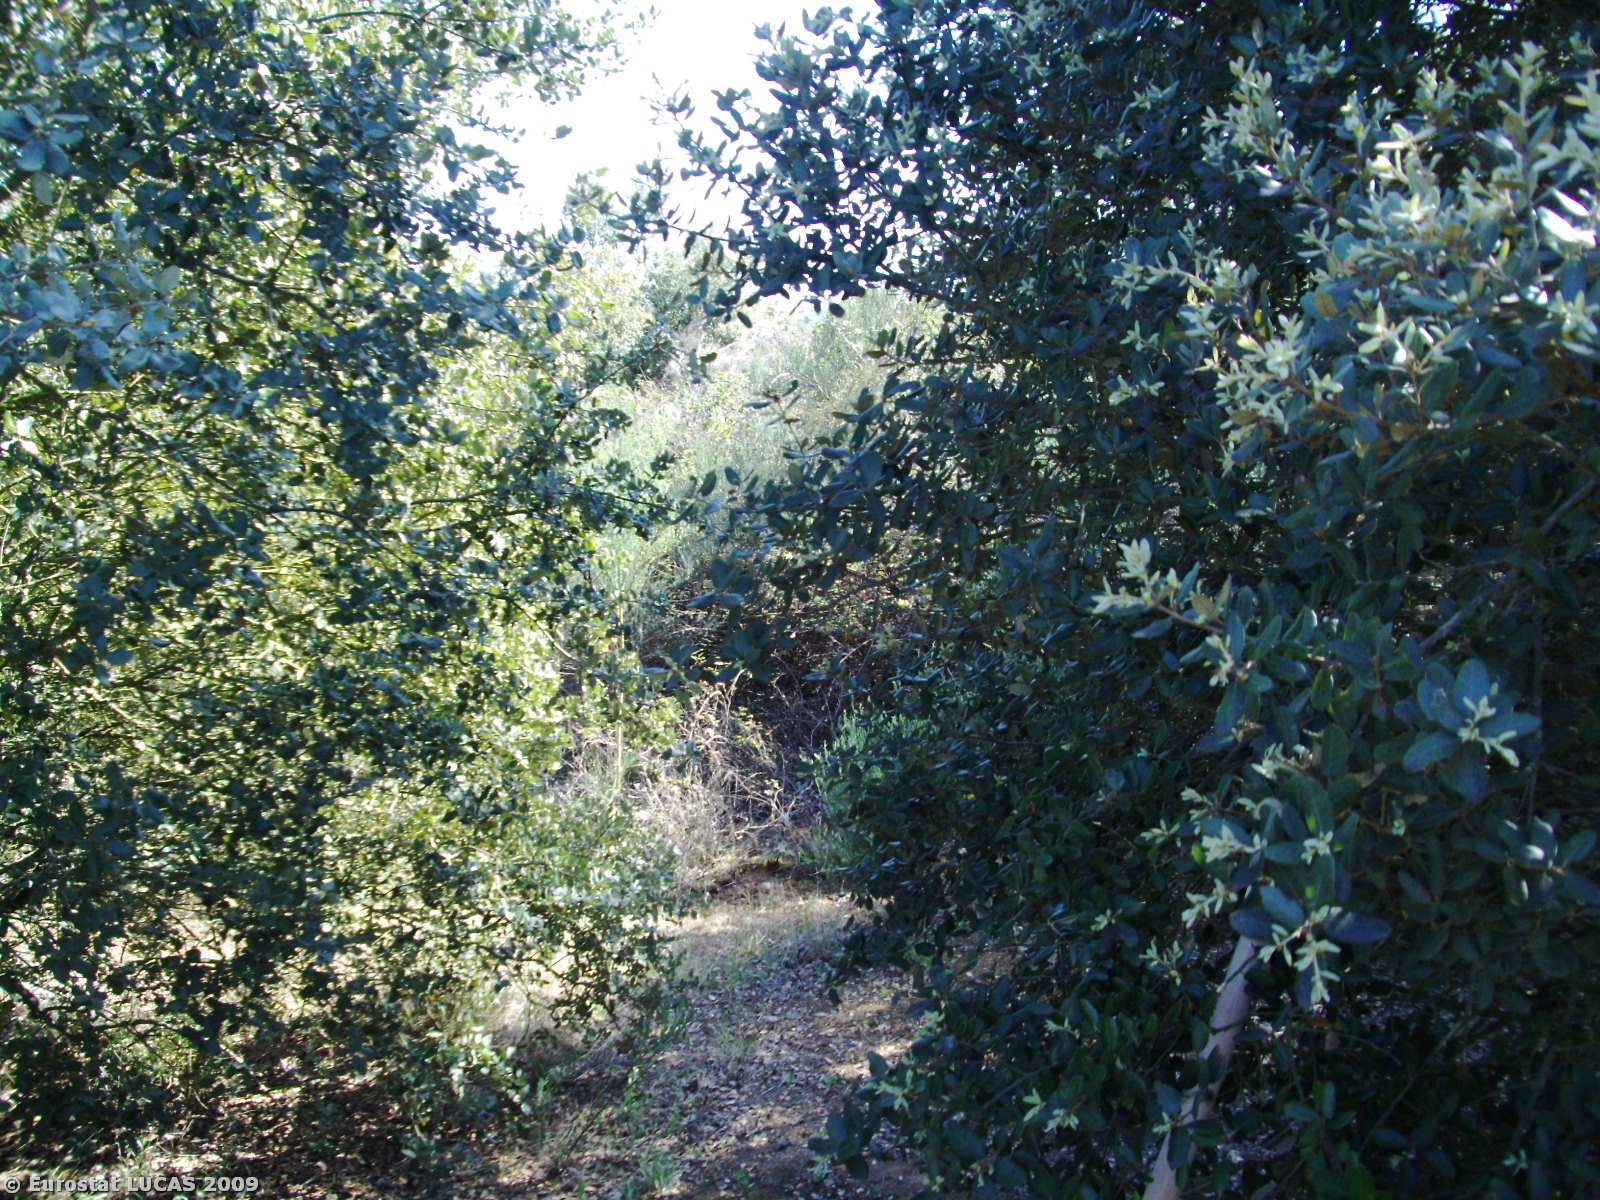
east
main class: Woodland
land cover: Broadleaved woodland
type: broadleaved evergreen forest
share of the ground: > 75 %
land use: Forestry
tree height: > 5 m
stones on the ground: 25 - 50 %
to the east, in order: Broadleaved woodland; Bare land; Inland water bodies
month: May
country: PT
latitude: 40.8556
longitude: -6.8875
